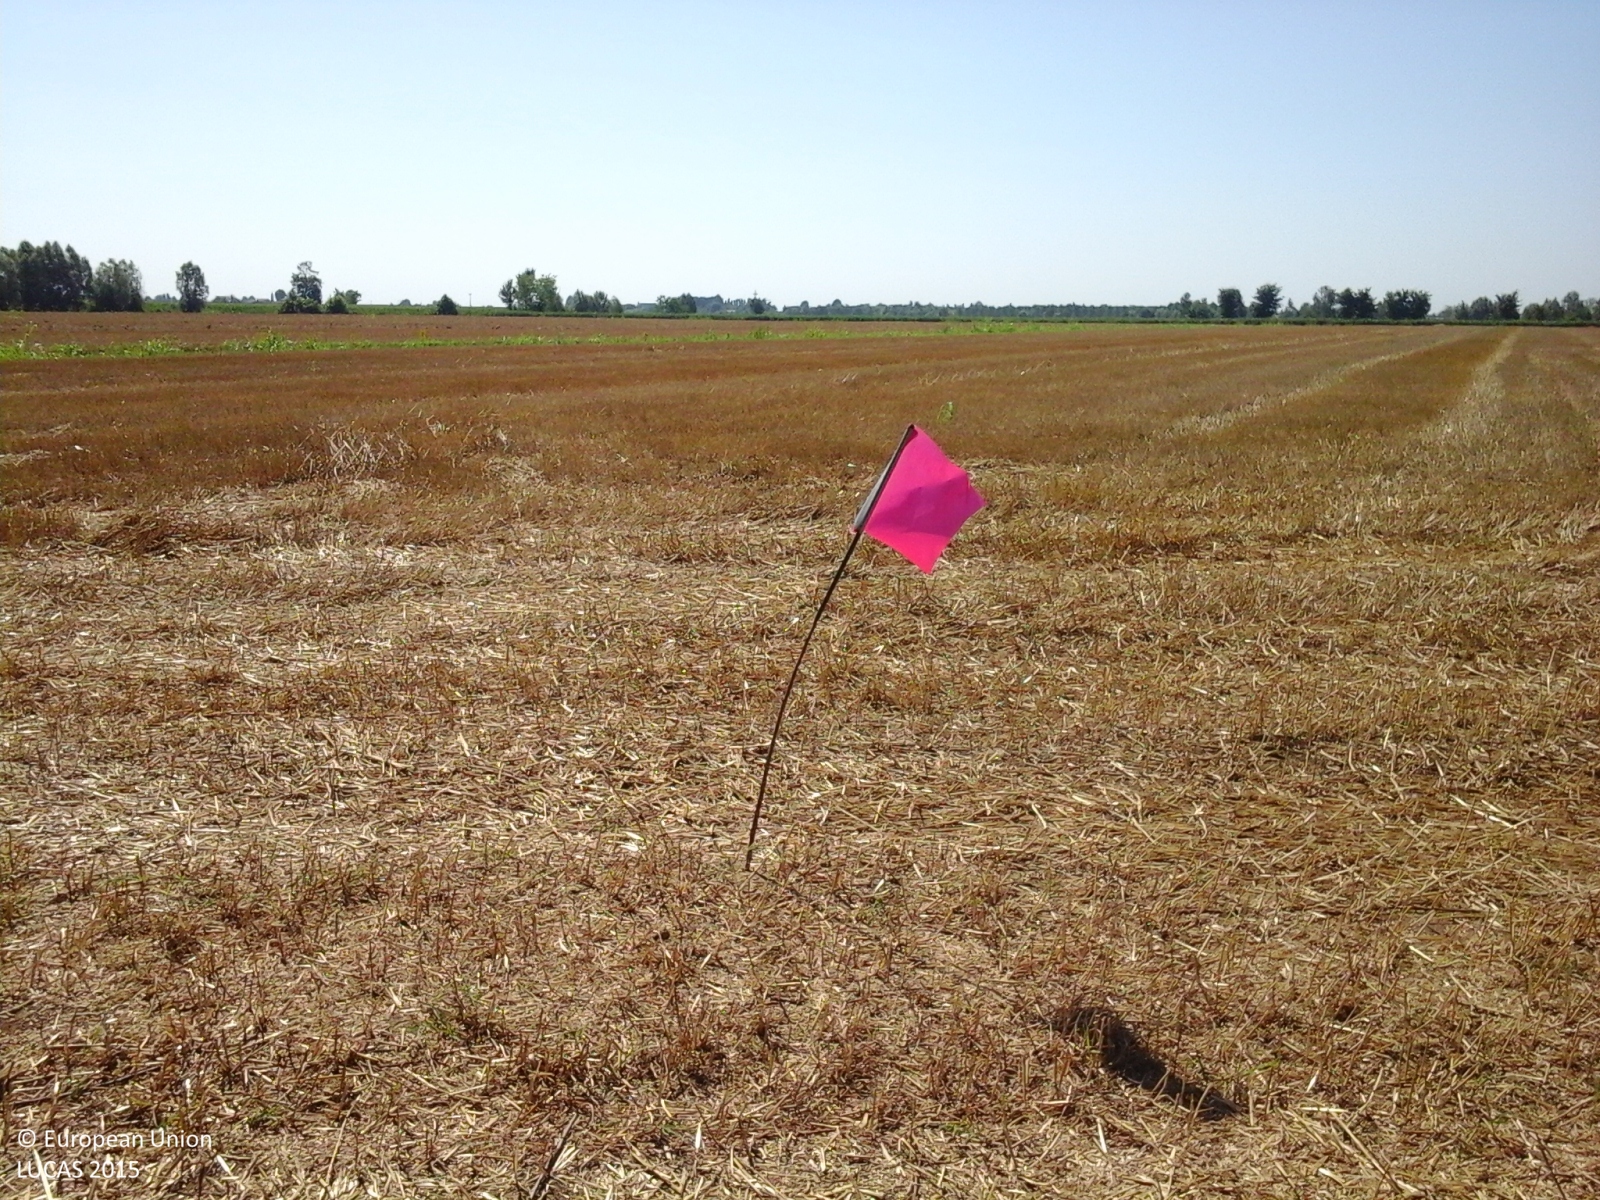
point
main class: Cropland
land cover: Common wheat
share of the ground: > 75 %
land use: Agriculture (excluding fallow land and kitchen gardens)
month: July
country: IT
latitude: 45.6947
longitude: 12.3467
